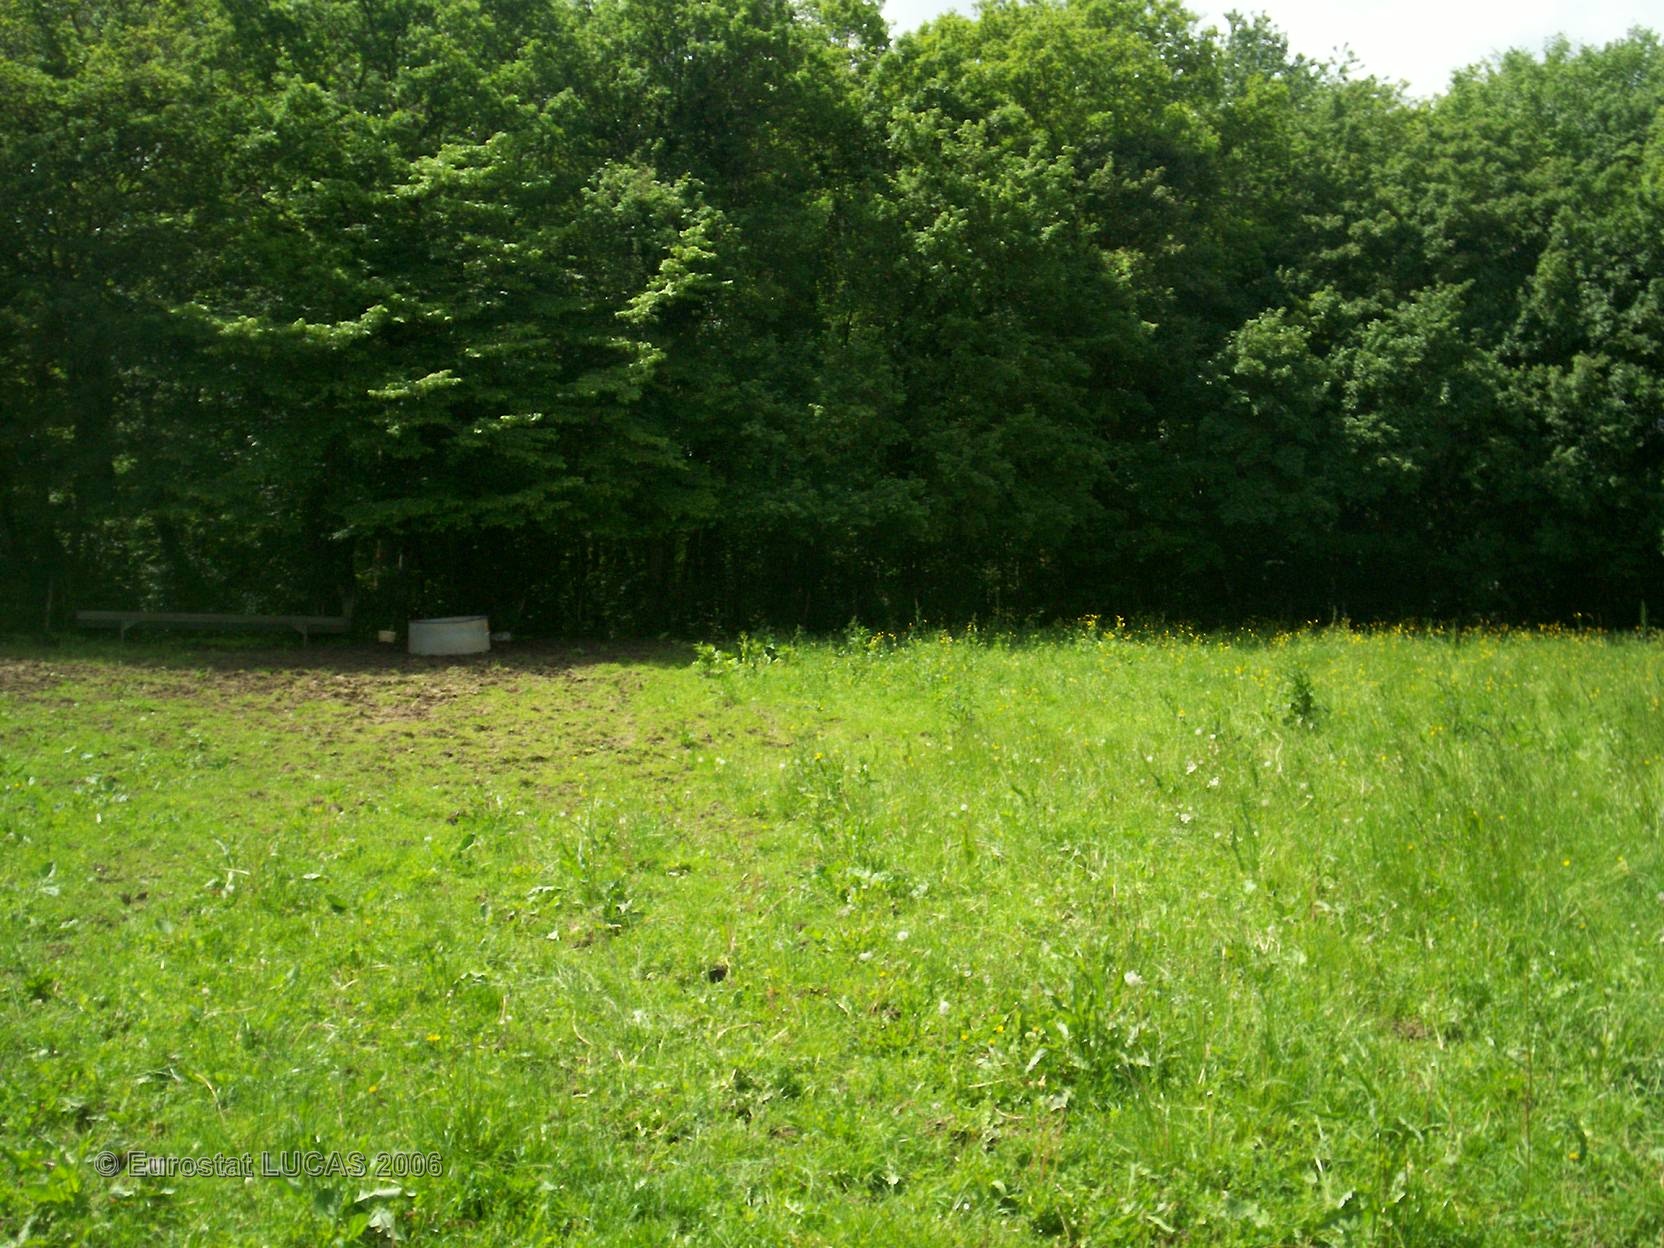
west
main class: Grassland
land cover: Grassland without tree/shrub cover
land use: Agriculture (excluding fallow land and kitchen gardens)
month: May
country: FR
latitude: 46.9907
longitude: 4.5962
